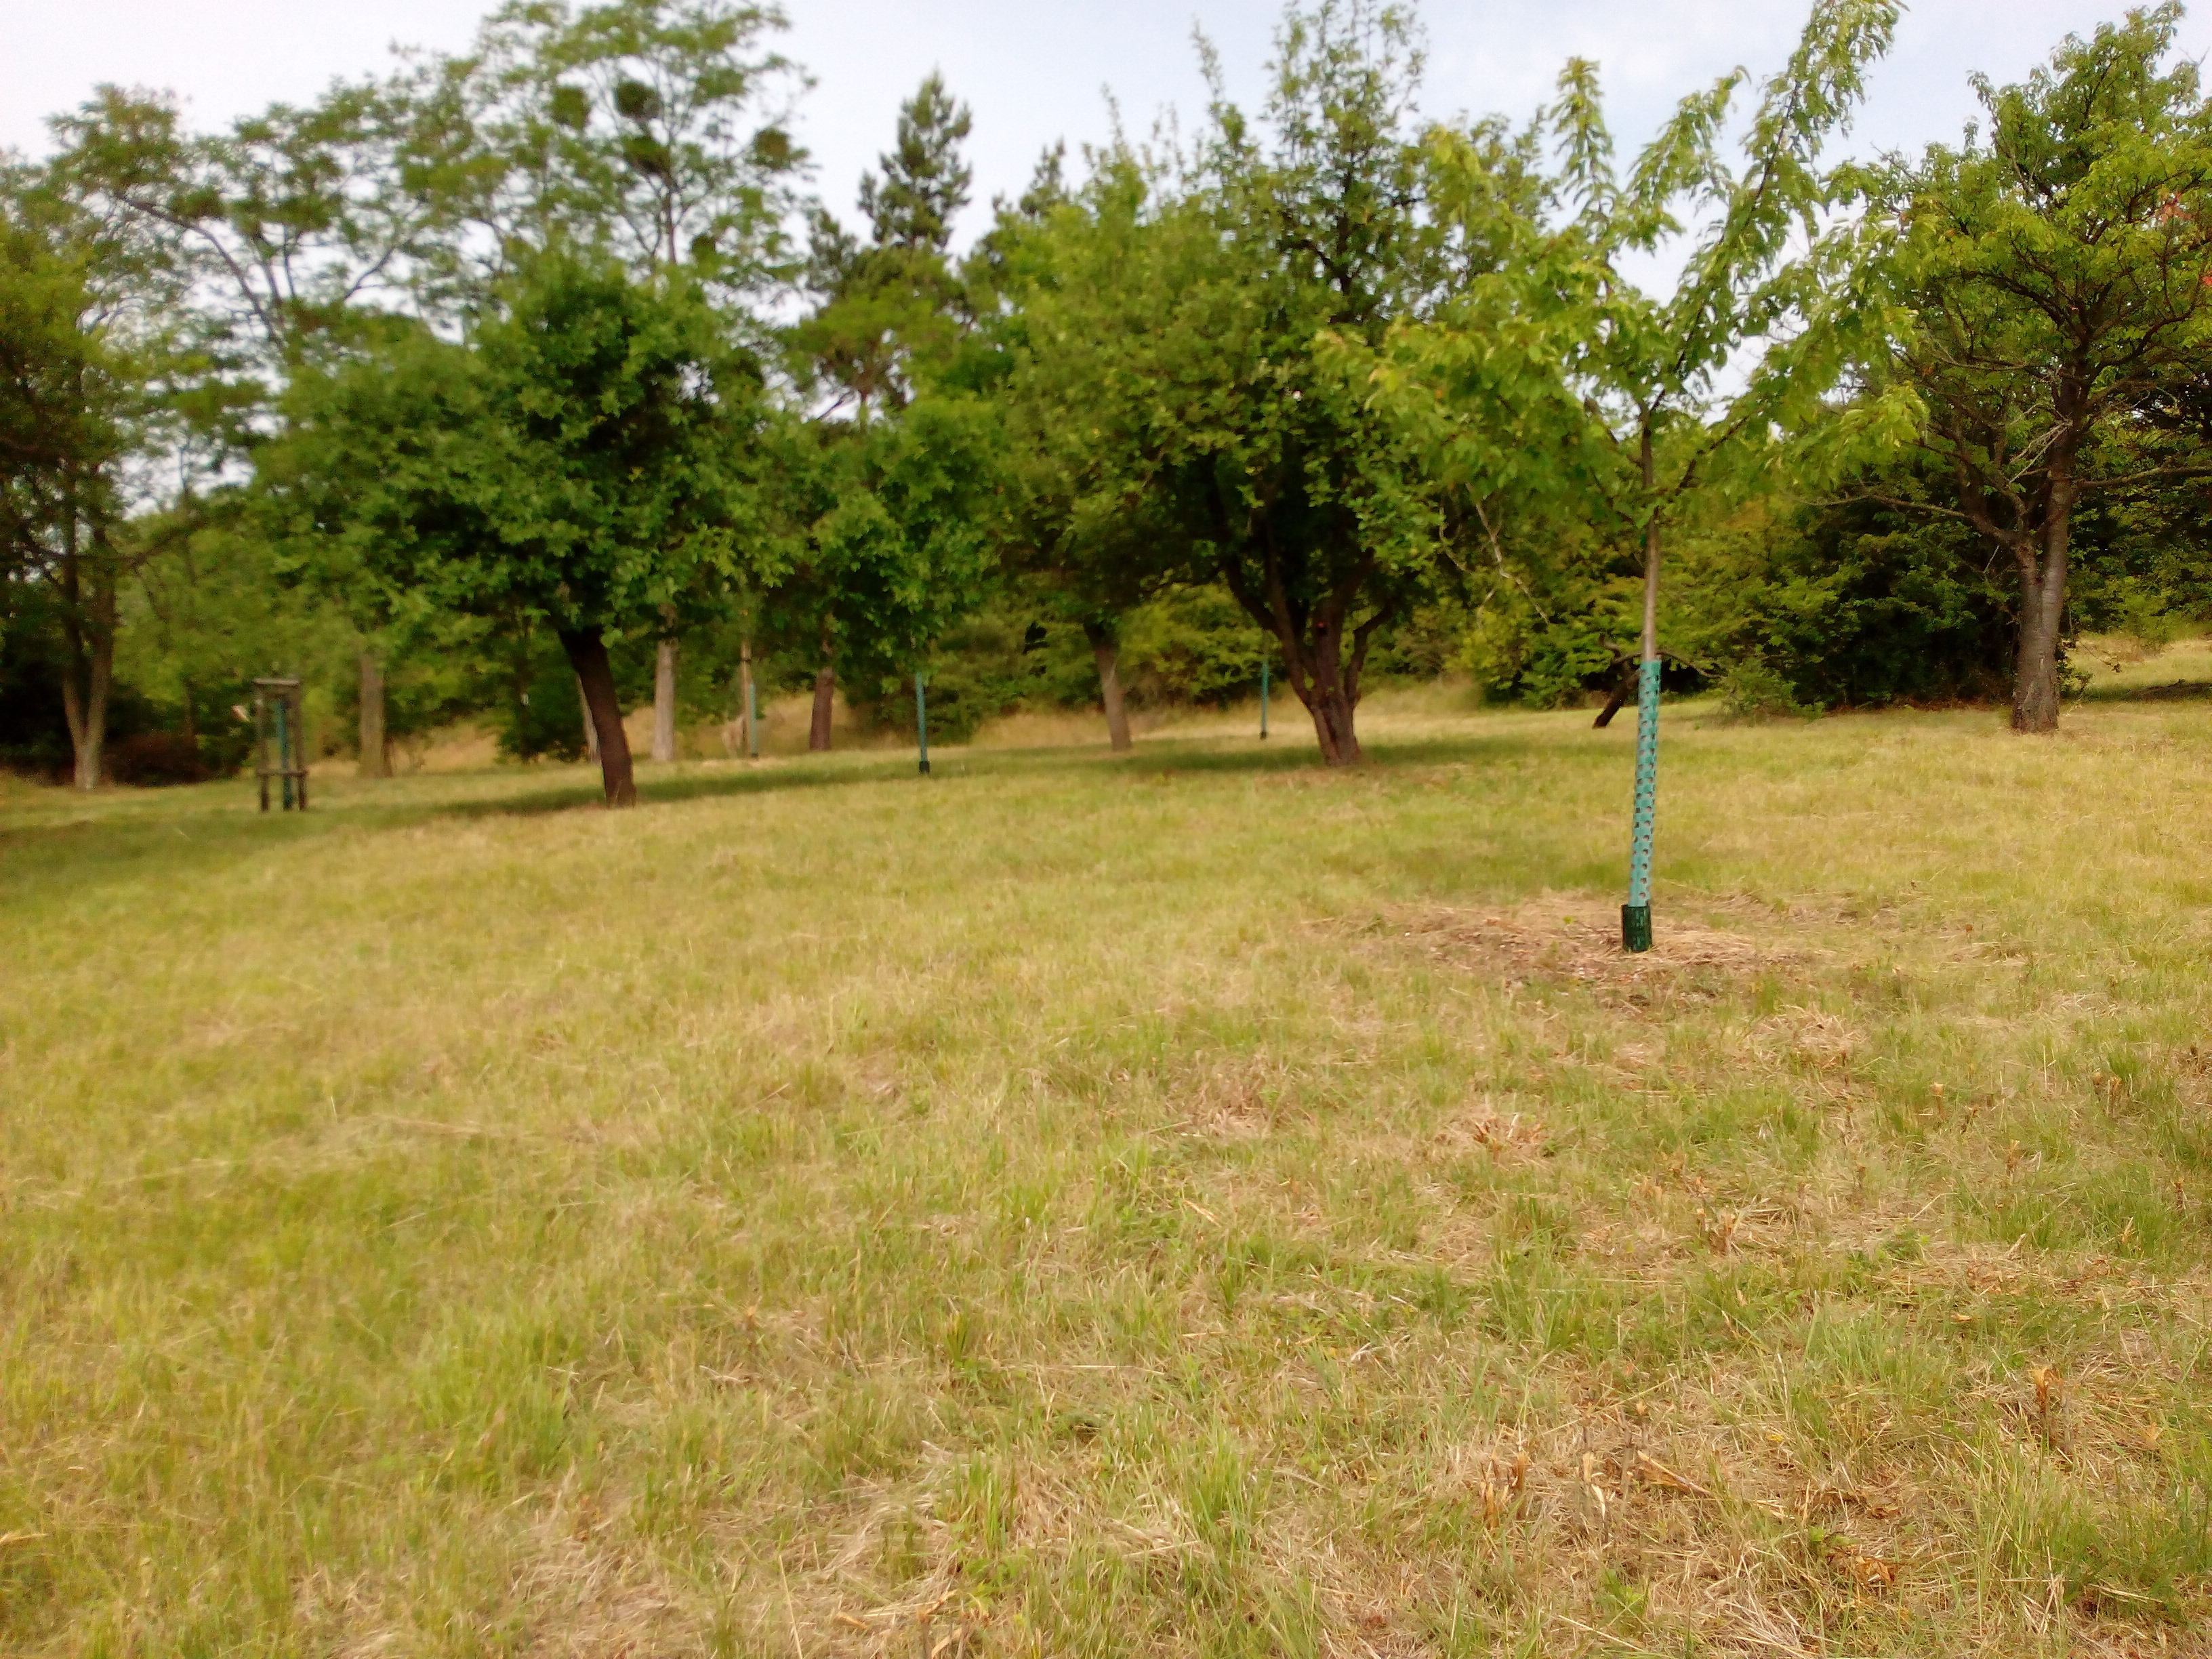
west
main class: Cropland
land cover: Apple fruit
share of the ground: 25 - 50 %
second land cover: Grassland without tree/shrub cover
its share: > 75 %
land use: Agriculture (excluding fallow land and kitchen gardens)
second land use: Amenities, museums, leisure
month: June
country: DE
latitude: 51.3656
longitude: 11.1057
